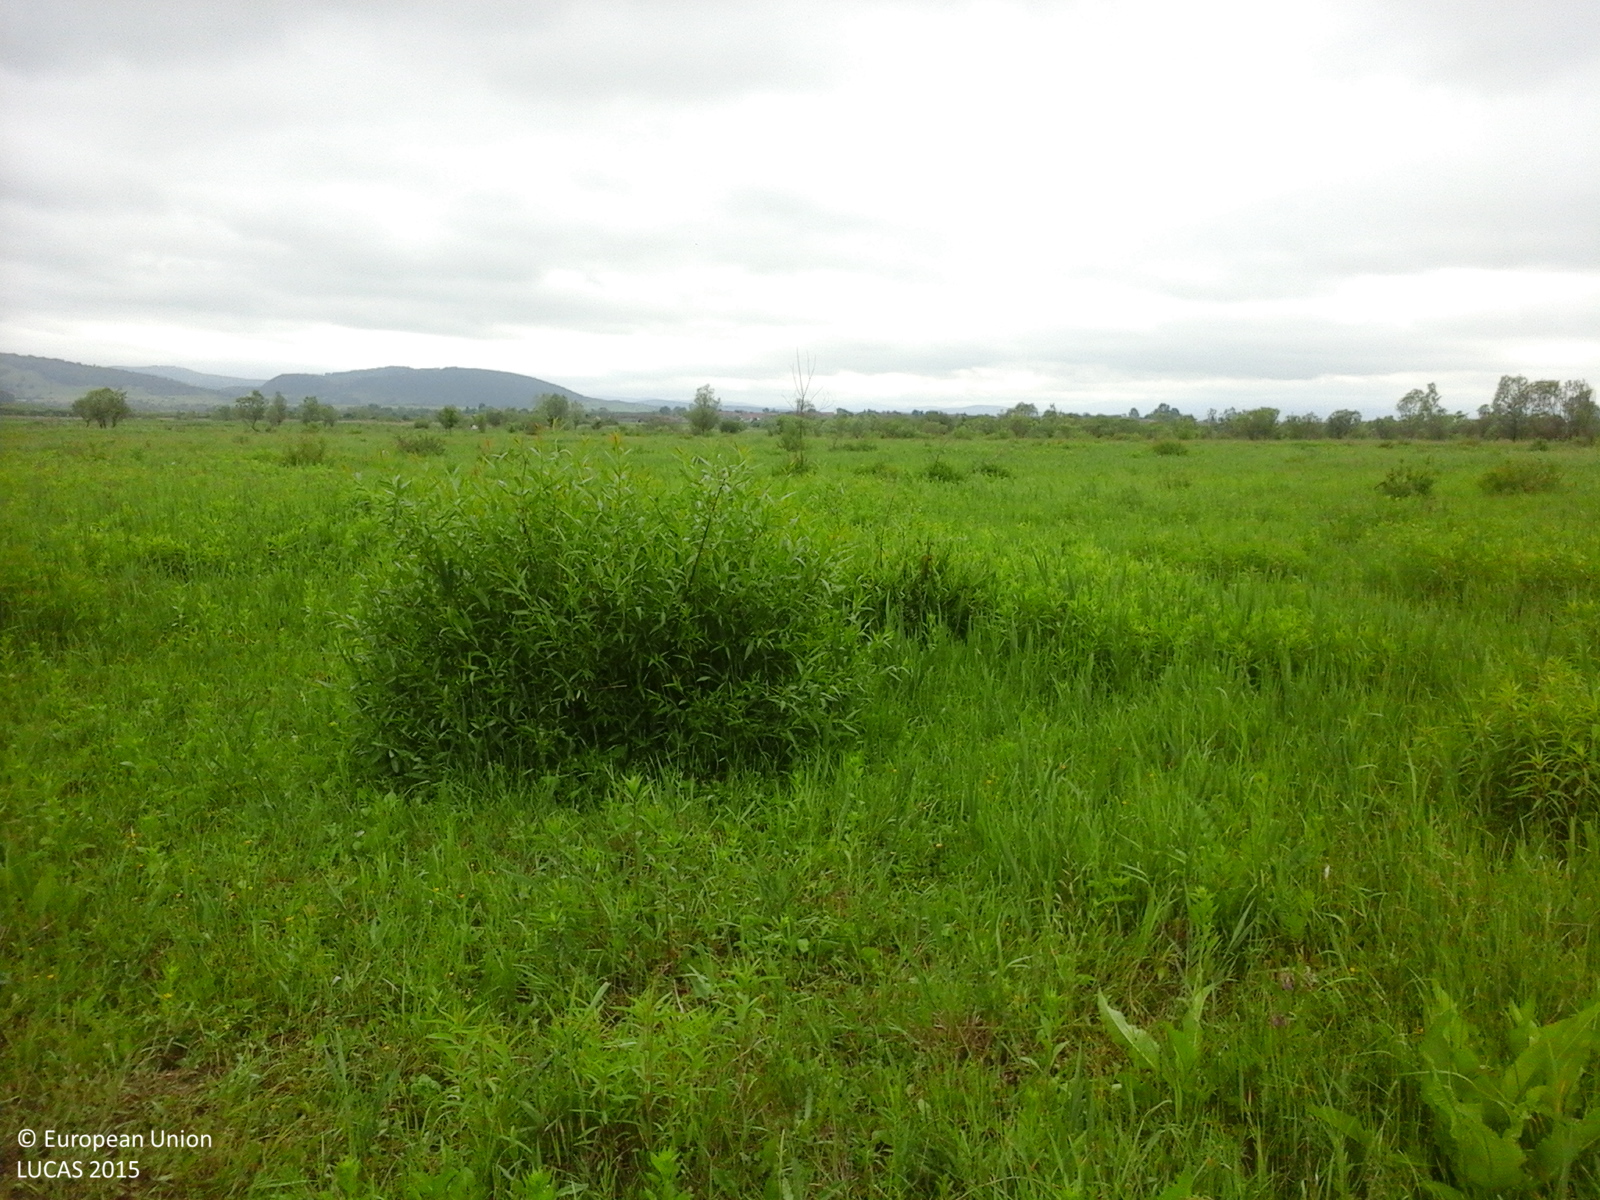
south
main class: Shrubland
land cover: Shrubland with sparse tree cover
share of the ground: > 75 %
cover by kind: herbaceous plants 85 %, shrubs 10 %, broadleaved forest trees 5 %
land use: Agriculture (excluding fallow land and kitchen gardens)
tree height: < 5 m
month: May
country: RO
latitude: 45.9309
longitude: 25.2256
